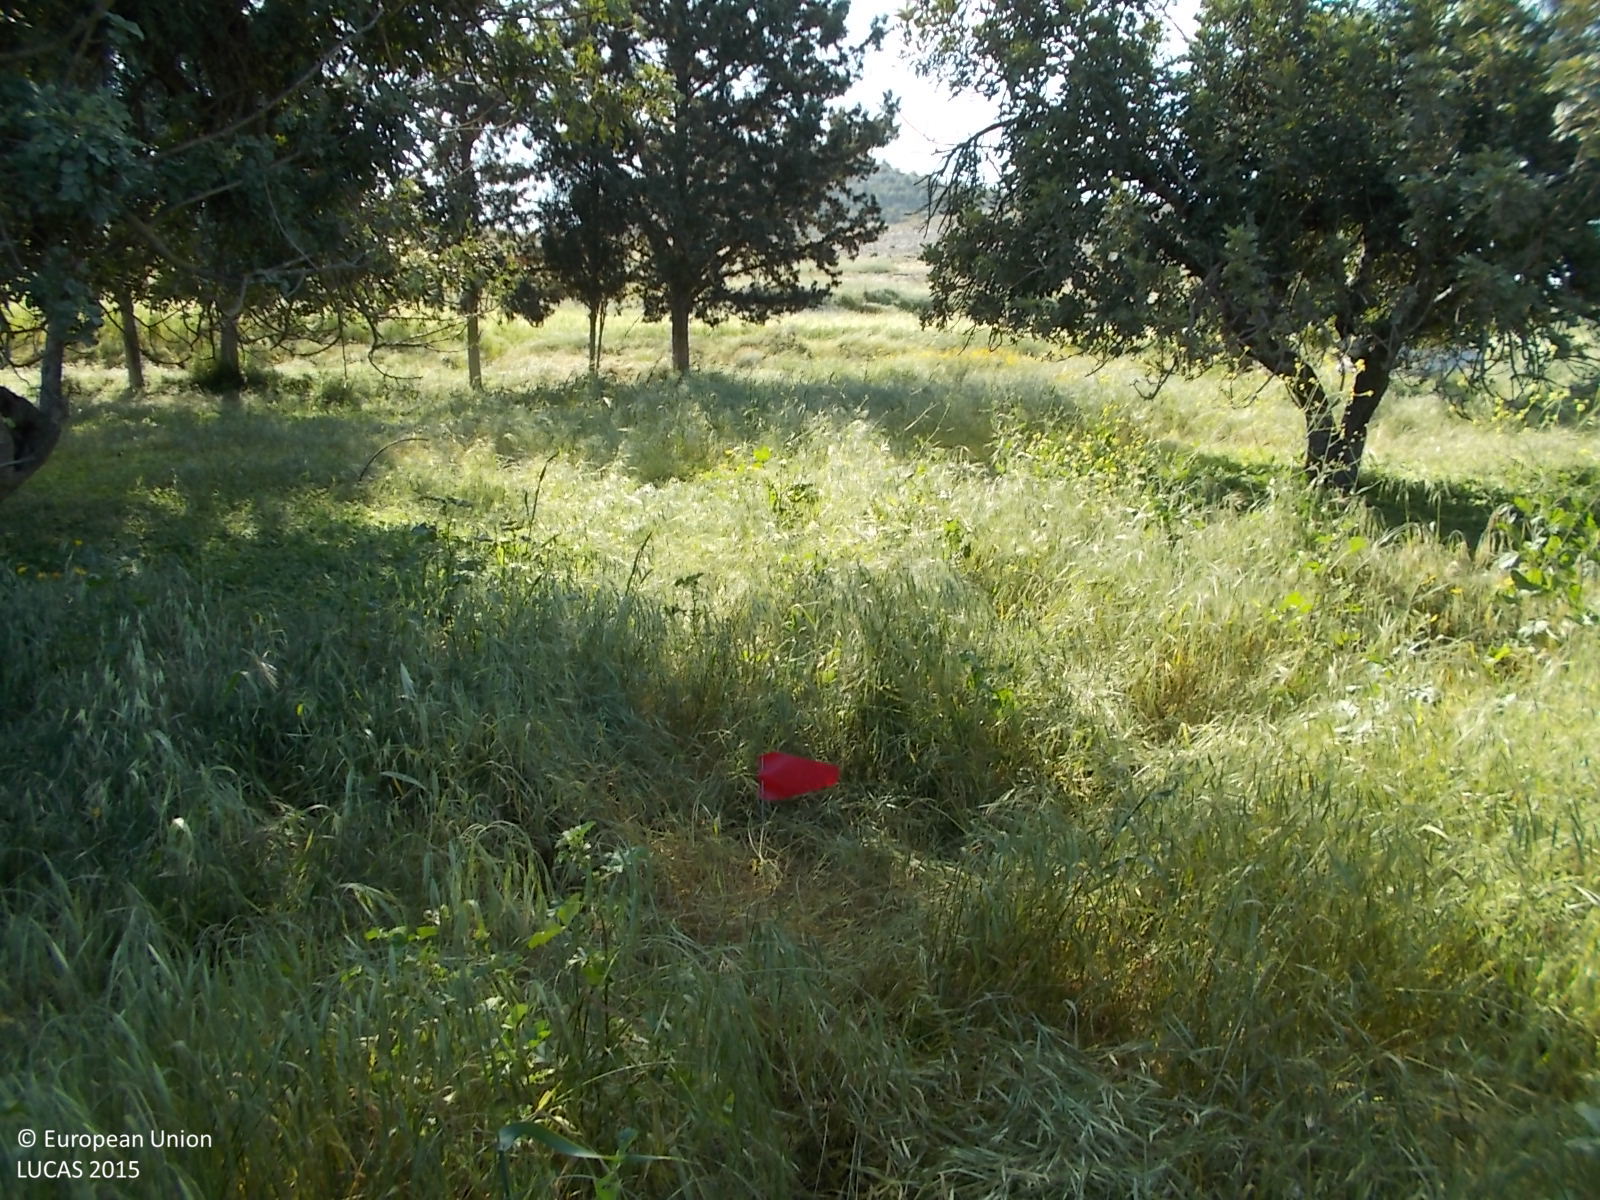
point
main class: Cropland
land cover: Other fruit trees and berries
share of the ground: 50 - 75 %
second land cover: Spontaneously vegetated surfaces
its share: > 75 %
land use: Agriculture (excluding fallow land and kitchen gardens)
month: April
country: CY
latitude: 34.9798
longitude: 33.5151
